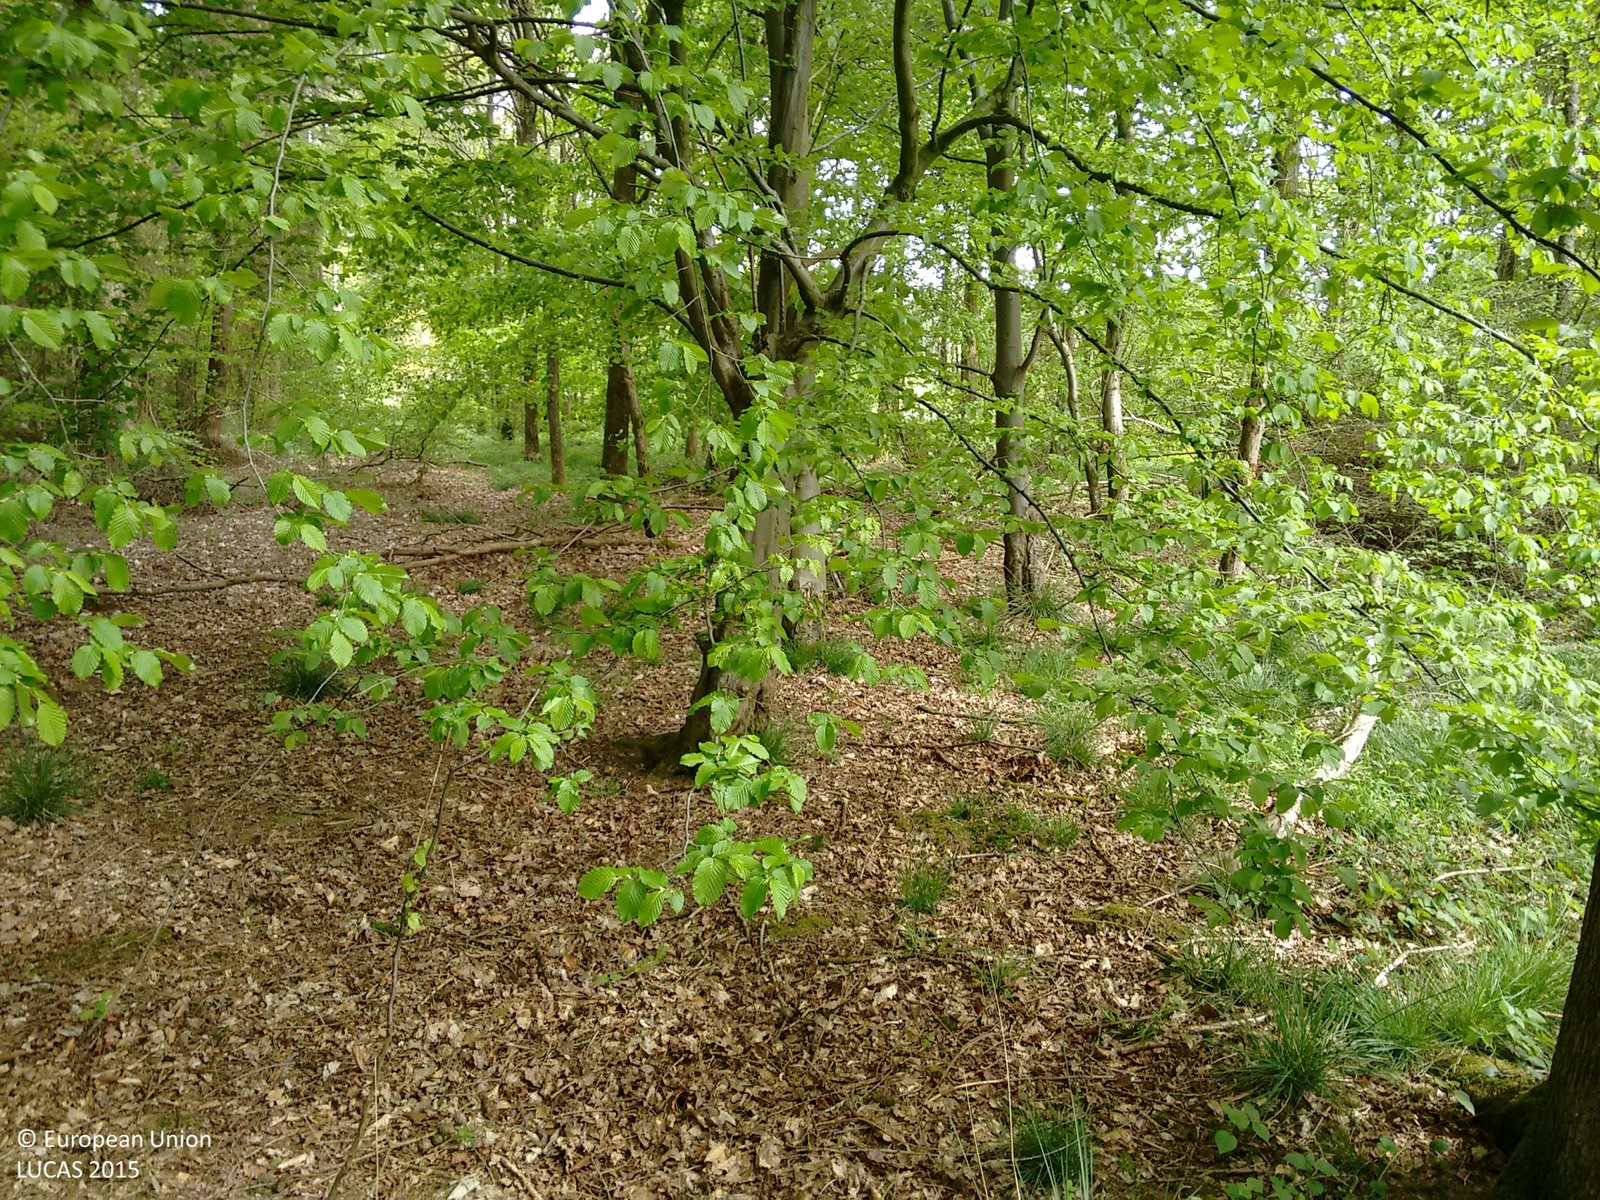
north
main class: Woodland
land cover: Other mixed woodland
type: beech forest
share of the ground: > 75 %
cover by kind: broadleaved forest trees 70 %, coniferous forest trees 25 %, herbaceous plants 5 %
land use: Forestry
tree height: > 5 m
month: May
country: GB
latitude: 51.8377
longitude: -0.5024
